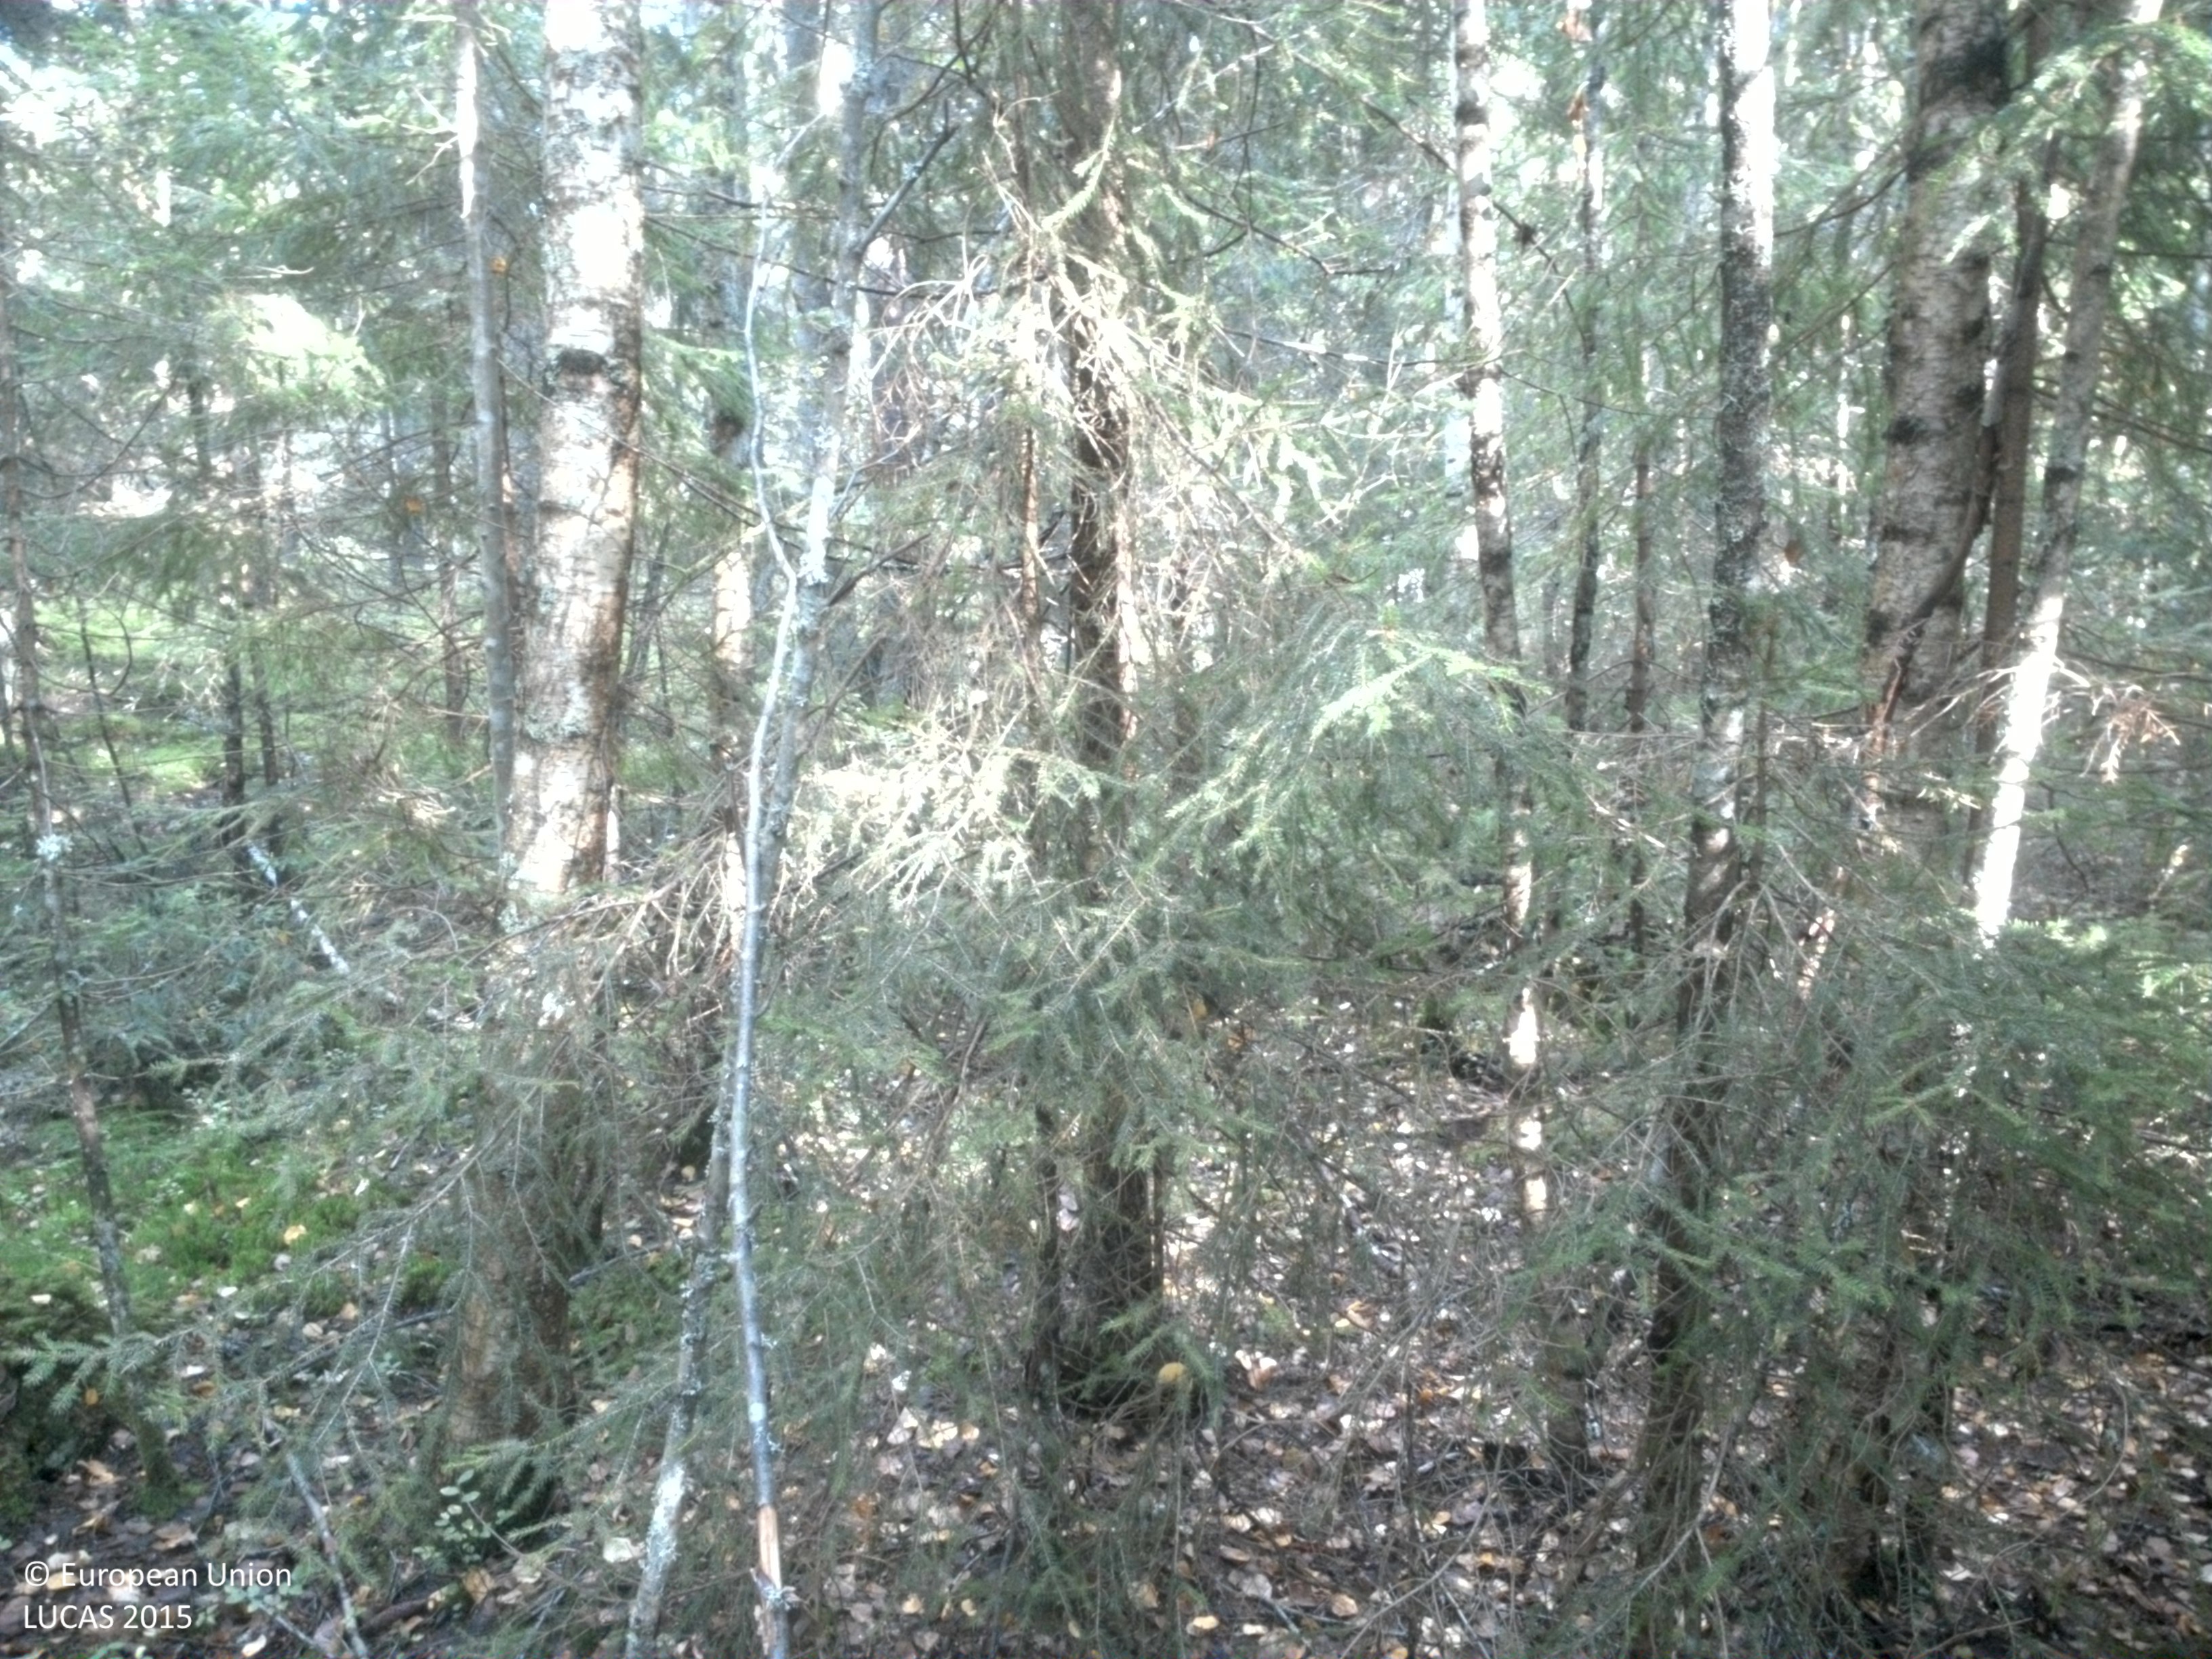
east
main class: Woodland
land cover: Spruce dominated mixed woodland
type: boreal forest
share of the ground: > 75 %
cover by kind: coniferous forest trees 55 %, broadleaved forest trees 25 %, lichens and mosses 15 %, shrubs 5 %
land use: Forestry
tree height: > 5 m
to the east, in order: Spruce dominated mixed woodland; Abandoned hedges; Artificial constructions in urban areas; Pine dominated mixed woodland; Broadleaved woodland; Shrubland with sparse tree cover
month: September
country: SE
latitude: 59.9090
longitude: 15.5508
